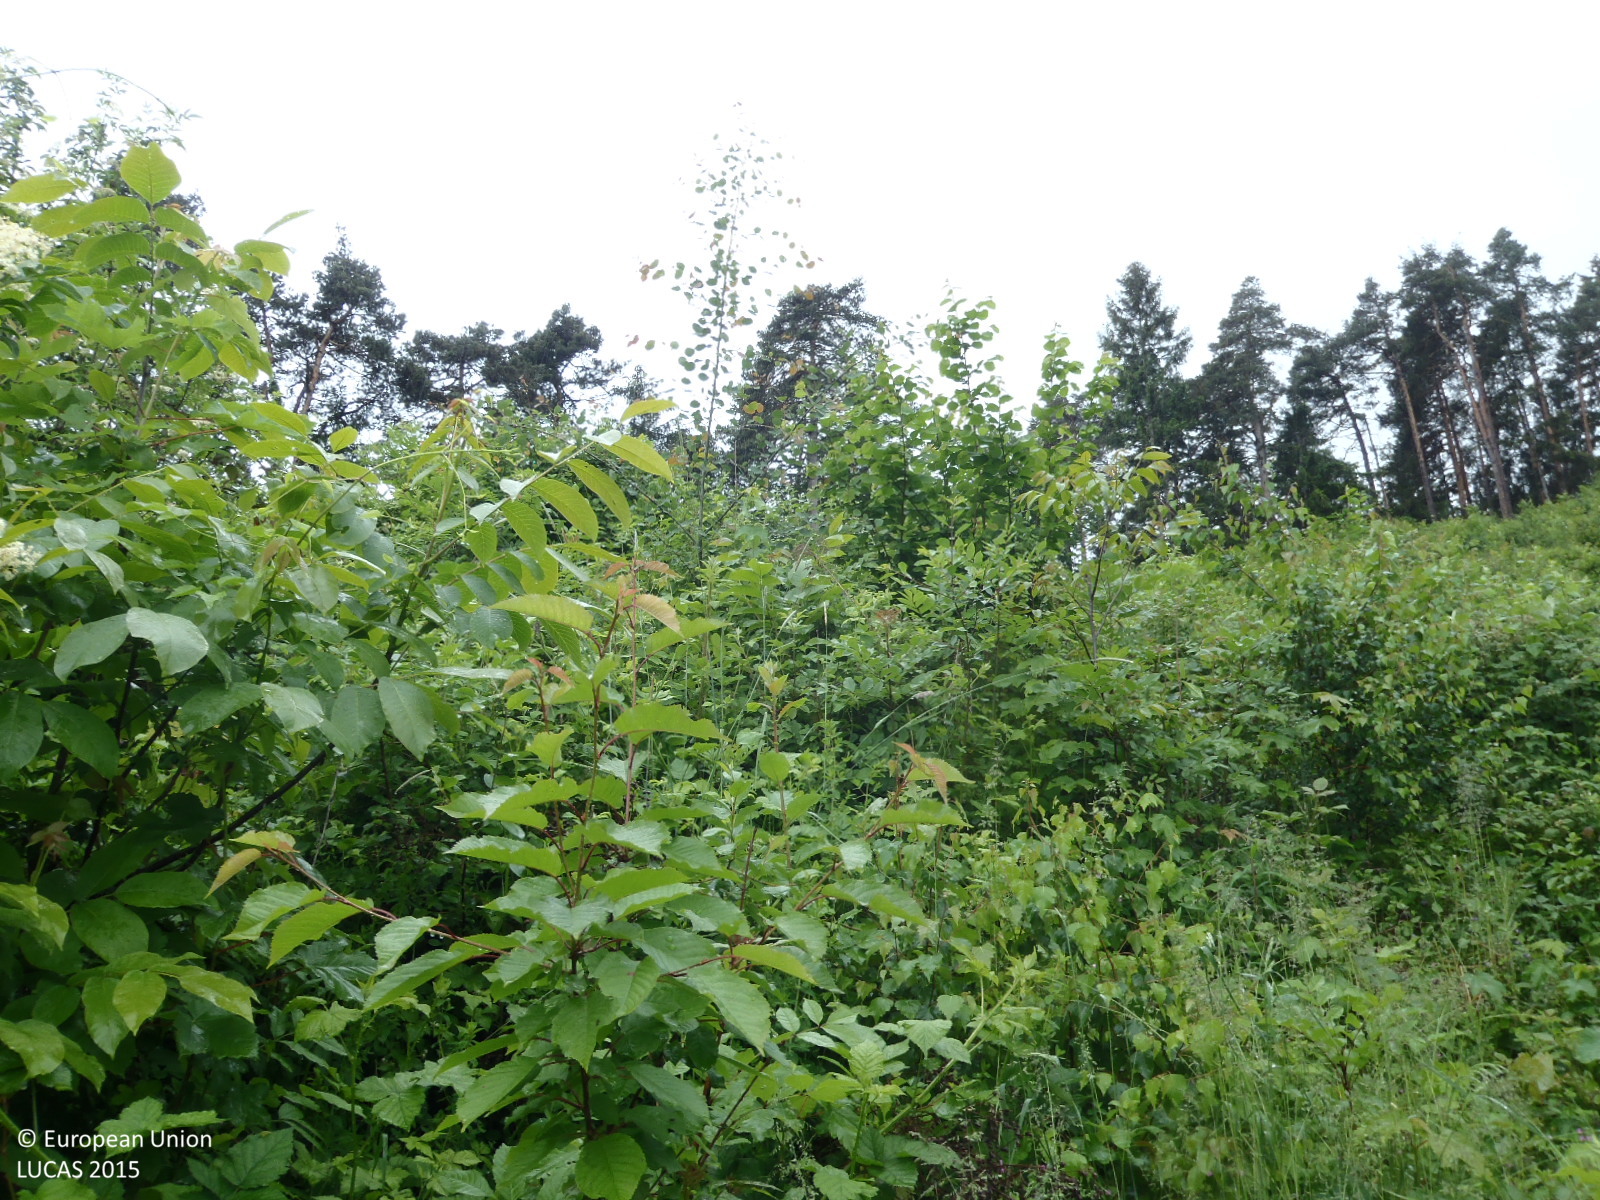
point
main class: Shrubland
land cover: Shrubland with sparse tree cover
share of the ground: > 75 %
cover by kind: shrubs 85 %, herbaceous plants 10 %, broadleaved forest trees 5 %
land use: Forestry
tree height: < 5 m
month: May
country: AT
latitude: 47.2957
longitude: 11.4666
